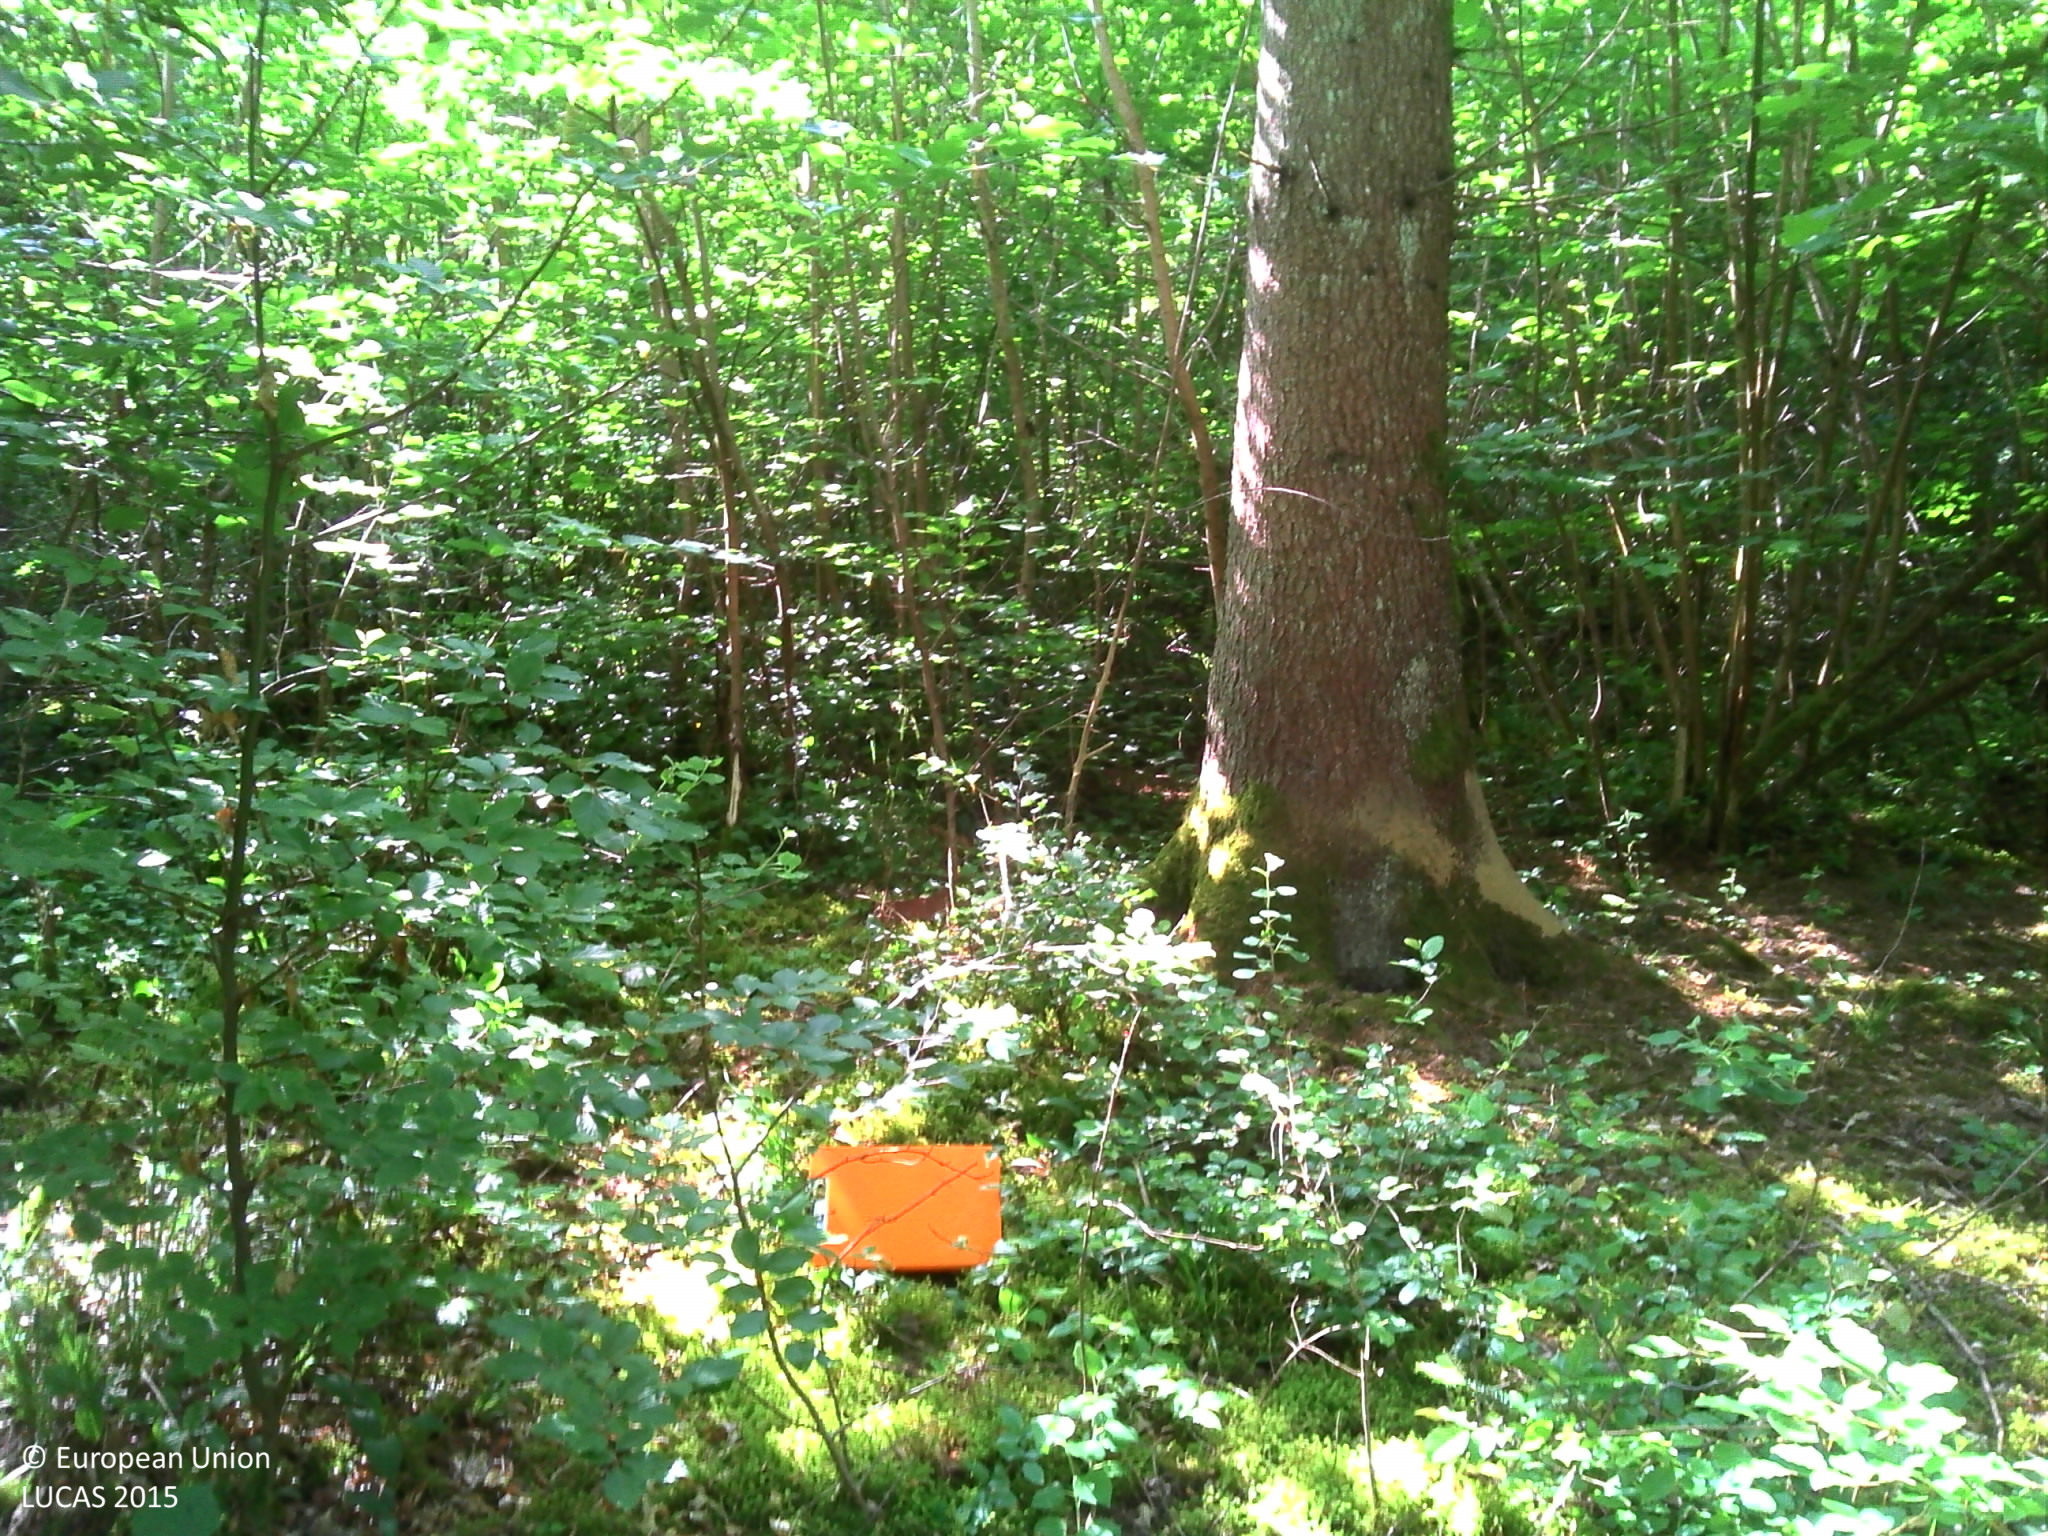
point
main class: Woodland
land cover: Spruce dominated mixed woodland
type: mesophytic deciduous forest
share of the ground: > 75 %
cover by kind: coniferous forest trees 45 %, broadleaved forest trees 45 %, herbaceous plants 10 %
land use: Forestry
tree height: > 5 m
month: June
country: FR
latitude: 47.7011
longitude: 6.0165
